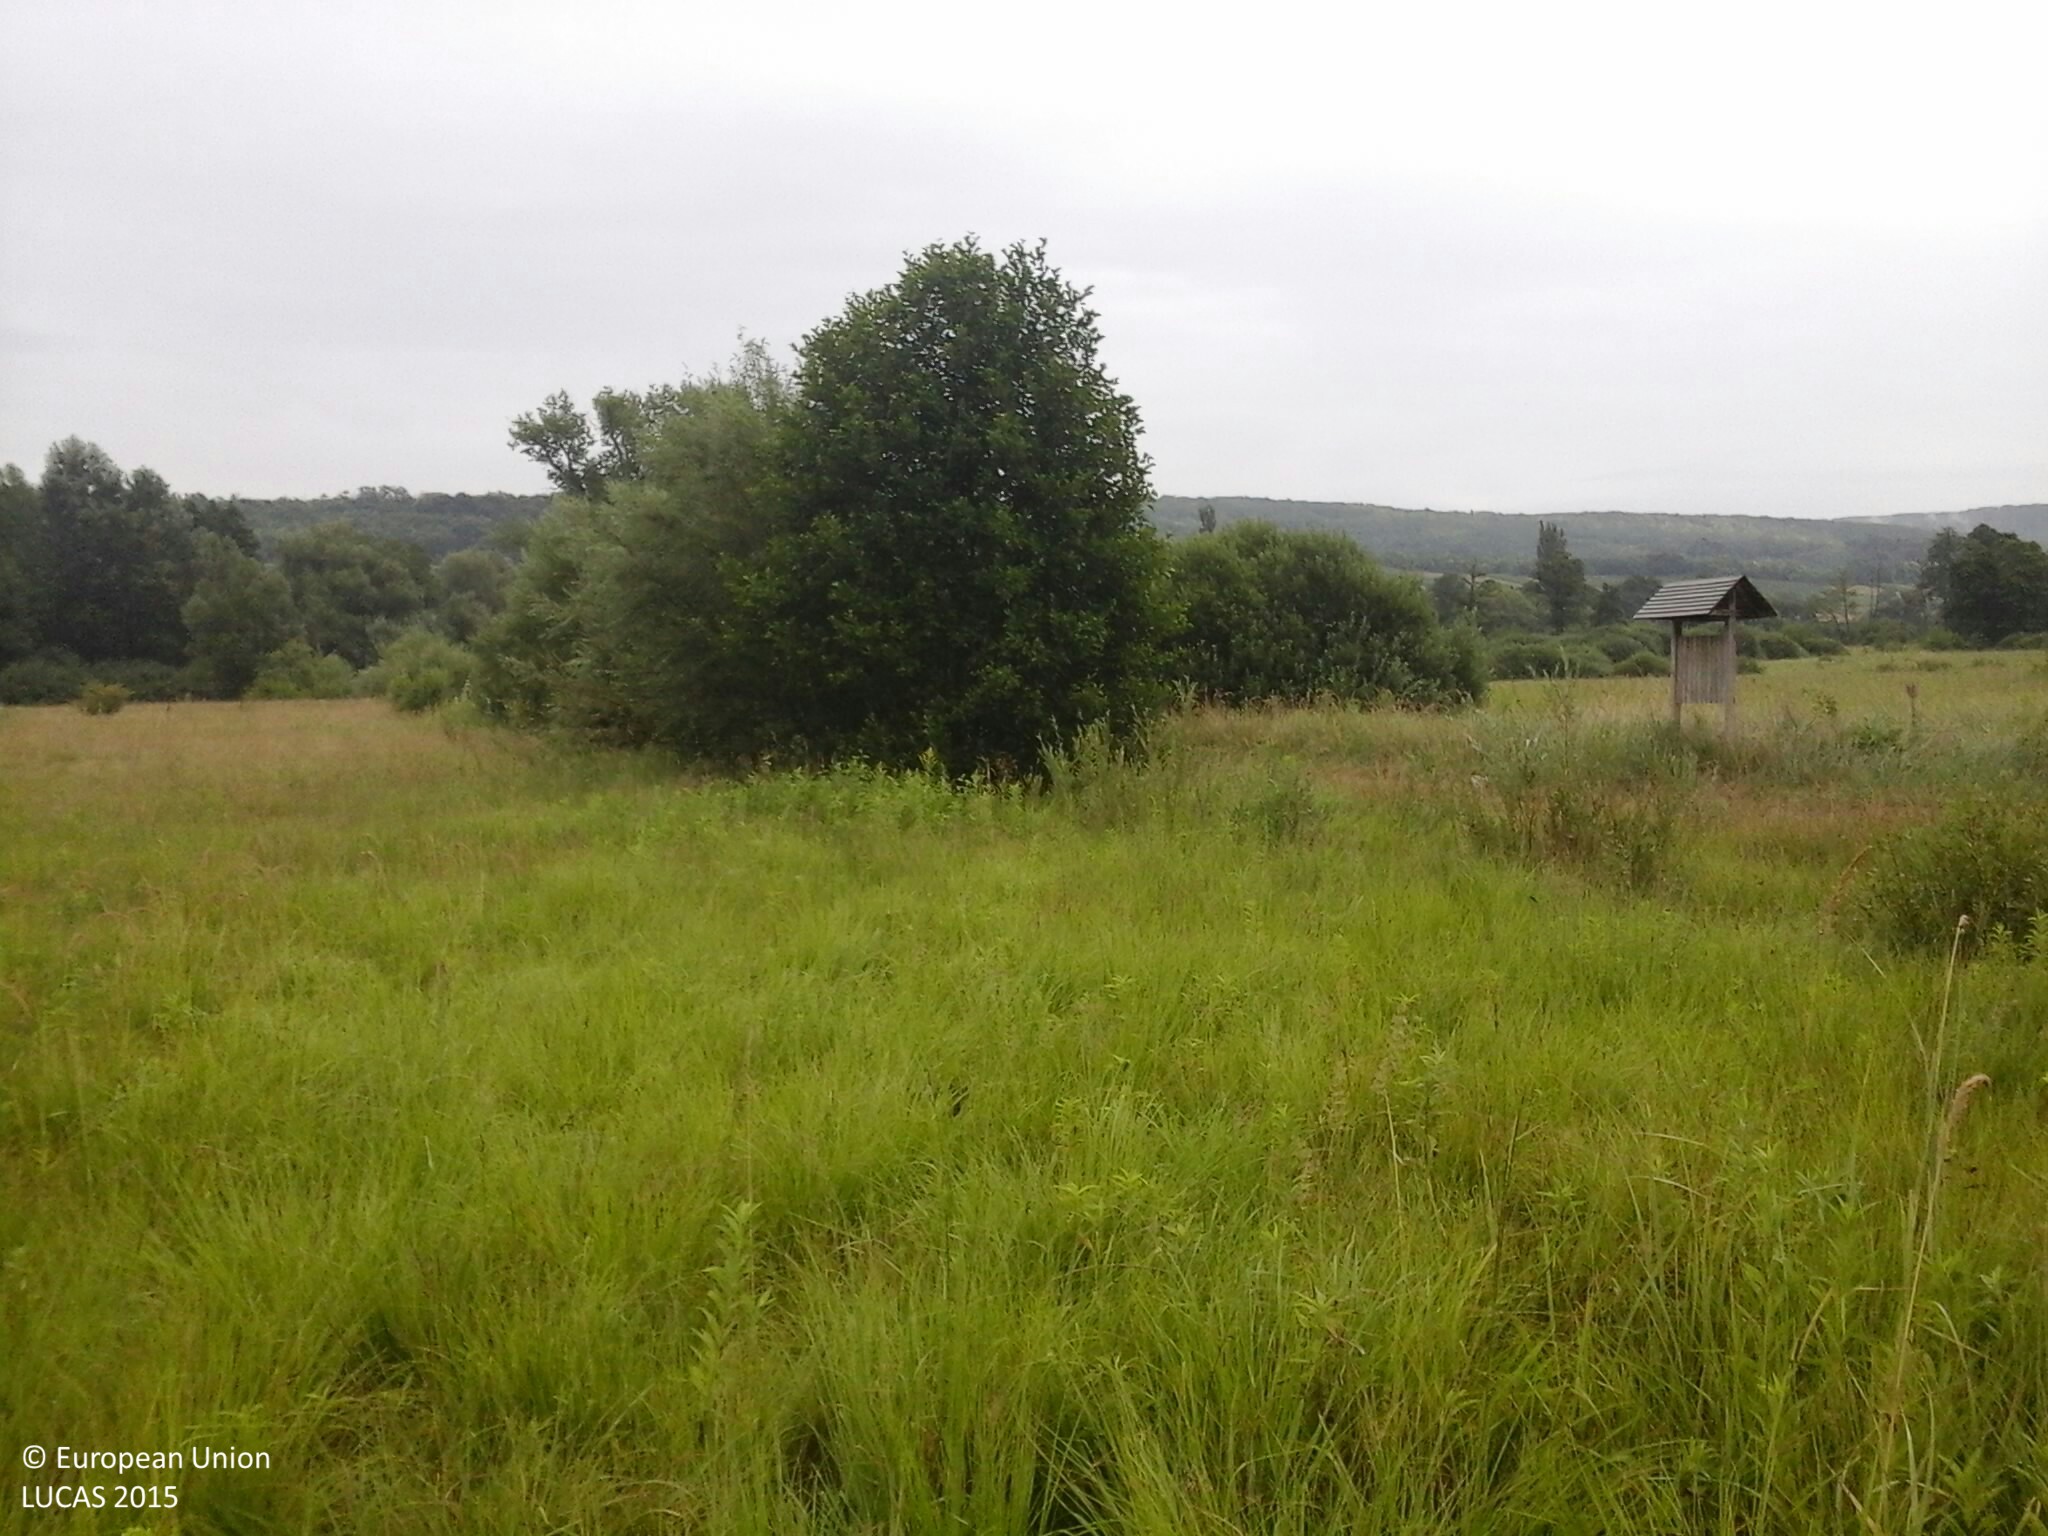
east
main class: Grassland
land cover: Spontaneously vegetated surfaces
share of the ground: > 75 %
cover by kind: herbaceous plants 100 %
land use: Semi-natural and natural areas not in use
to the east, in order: Spontaneously vegetated surfaces; Ditches and canals; Managed hedges; Grass margins; Tracks; Spontaneously vegetated surfaces; Shrubland with sparse tree cover; Grassland without tree/shrub cover
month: July
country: HU
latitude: 46.7378
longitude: 17.7678
